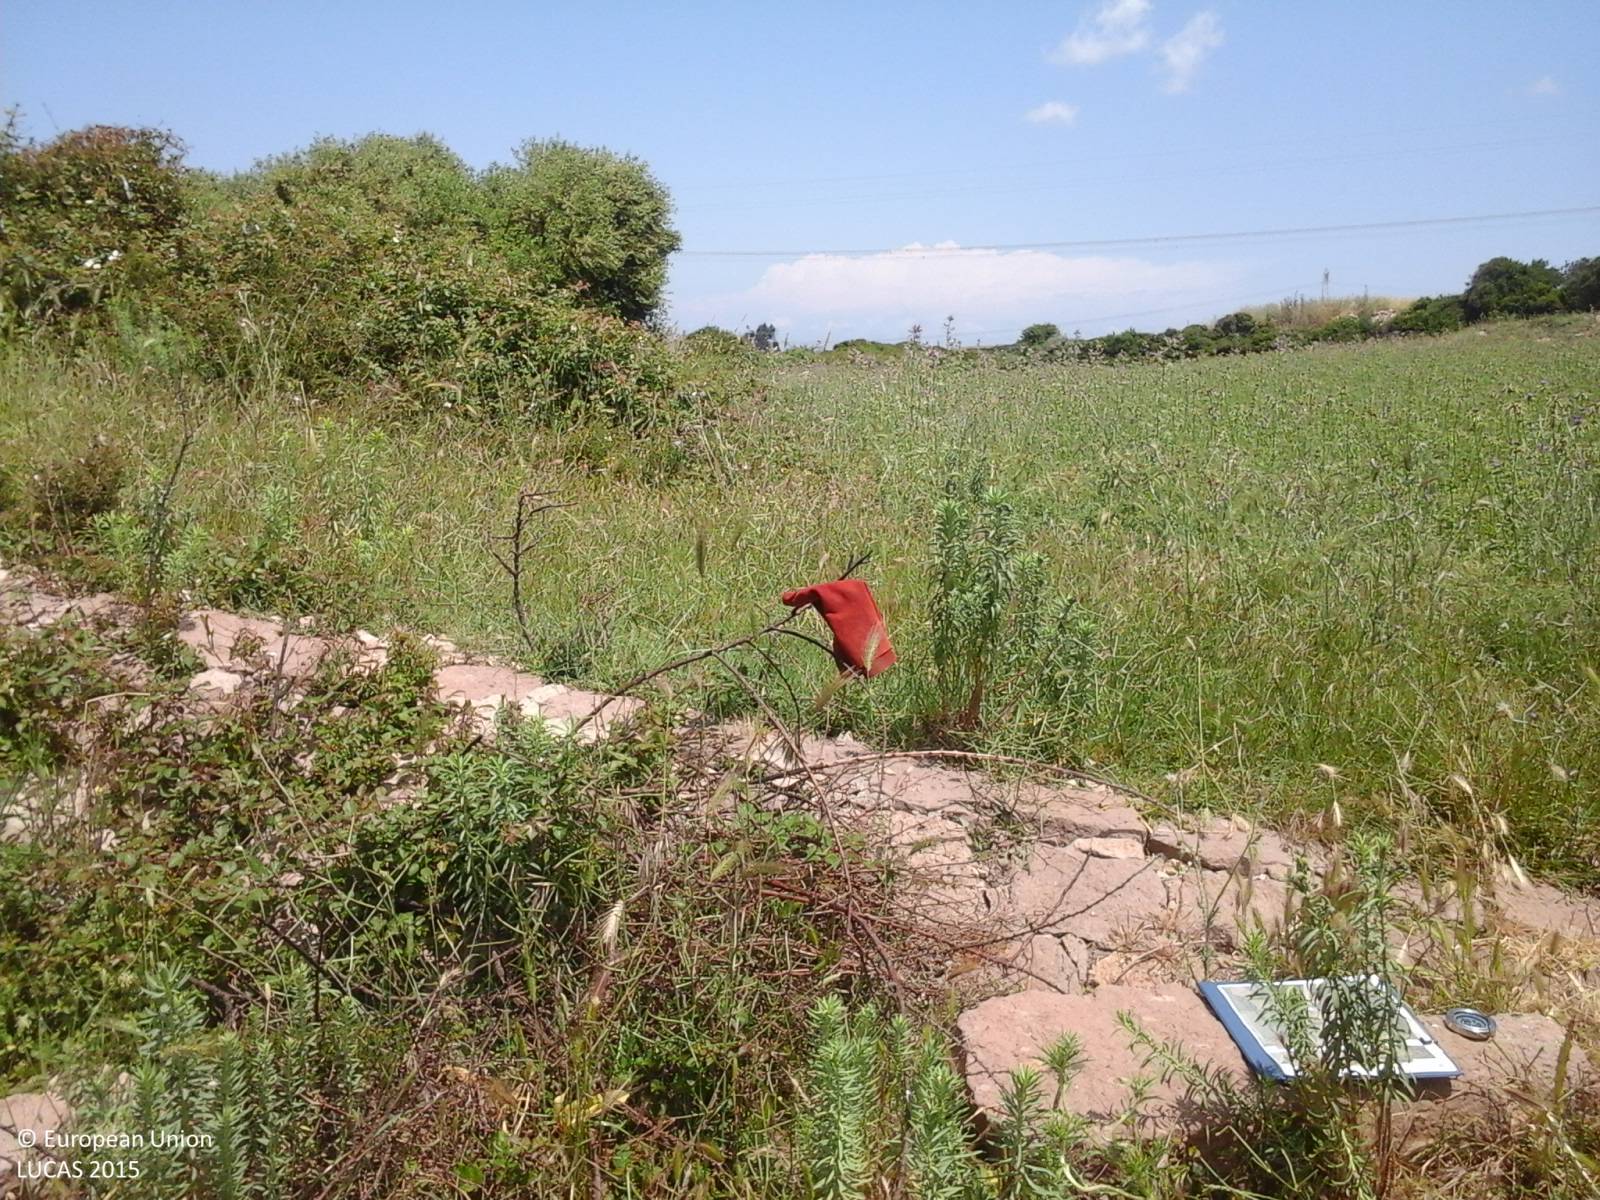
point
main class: Grassland
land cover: Spontaneously vegetated surfaces
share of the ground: > 75 %
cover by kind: herbaceous plants 50 %, shrubs 5 %, unconsolidated bare surface 5 %
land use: Agriculture (excluding fallow land and kitchen gardens)
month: May
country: IT
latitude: 40.7428
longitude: 8.3853
